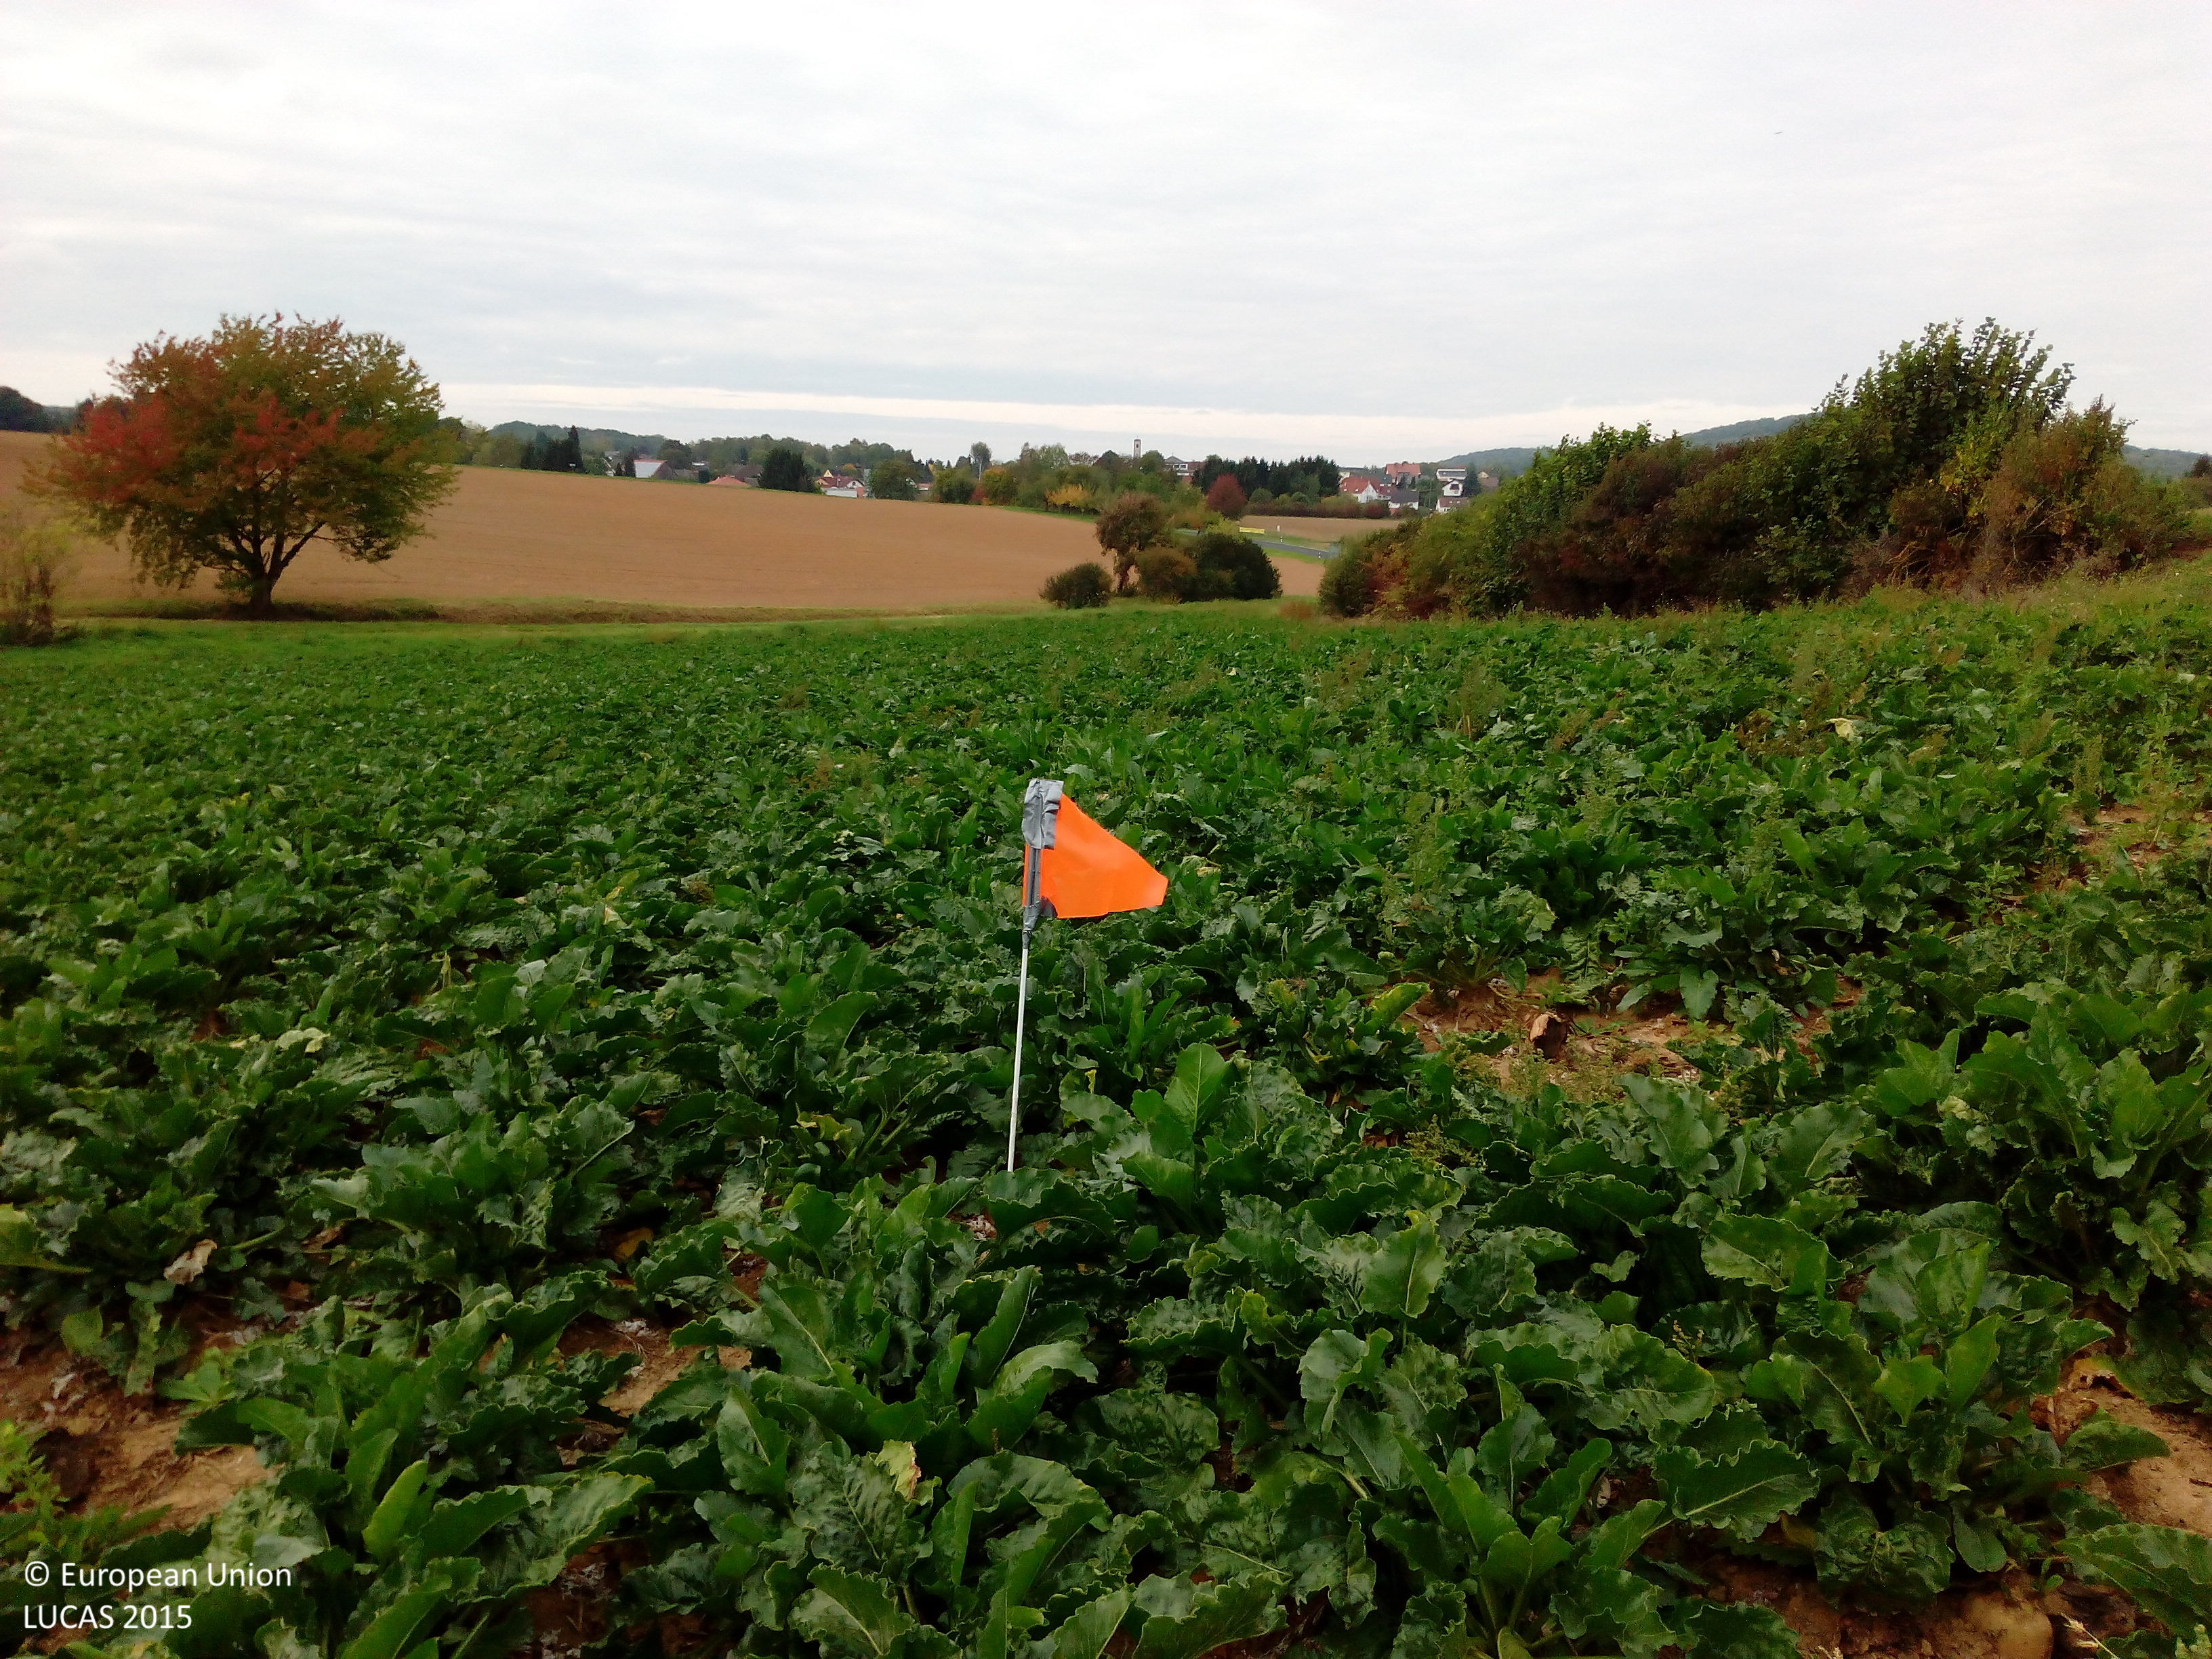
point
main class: Cropland
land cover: Sugar beet
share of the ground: > 75 %
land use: Agriculture (excluding fallow land and kitchen gardens)
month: October
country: DE
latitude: 50.1635
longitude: 9.2023
